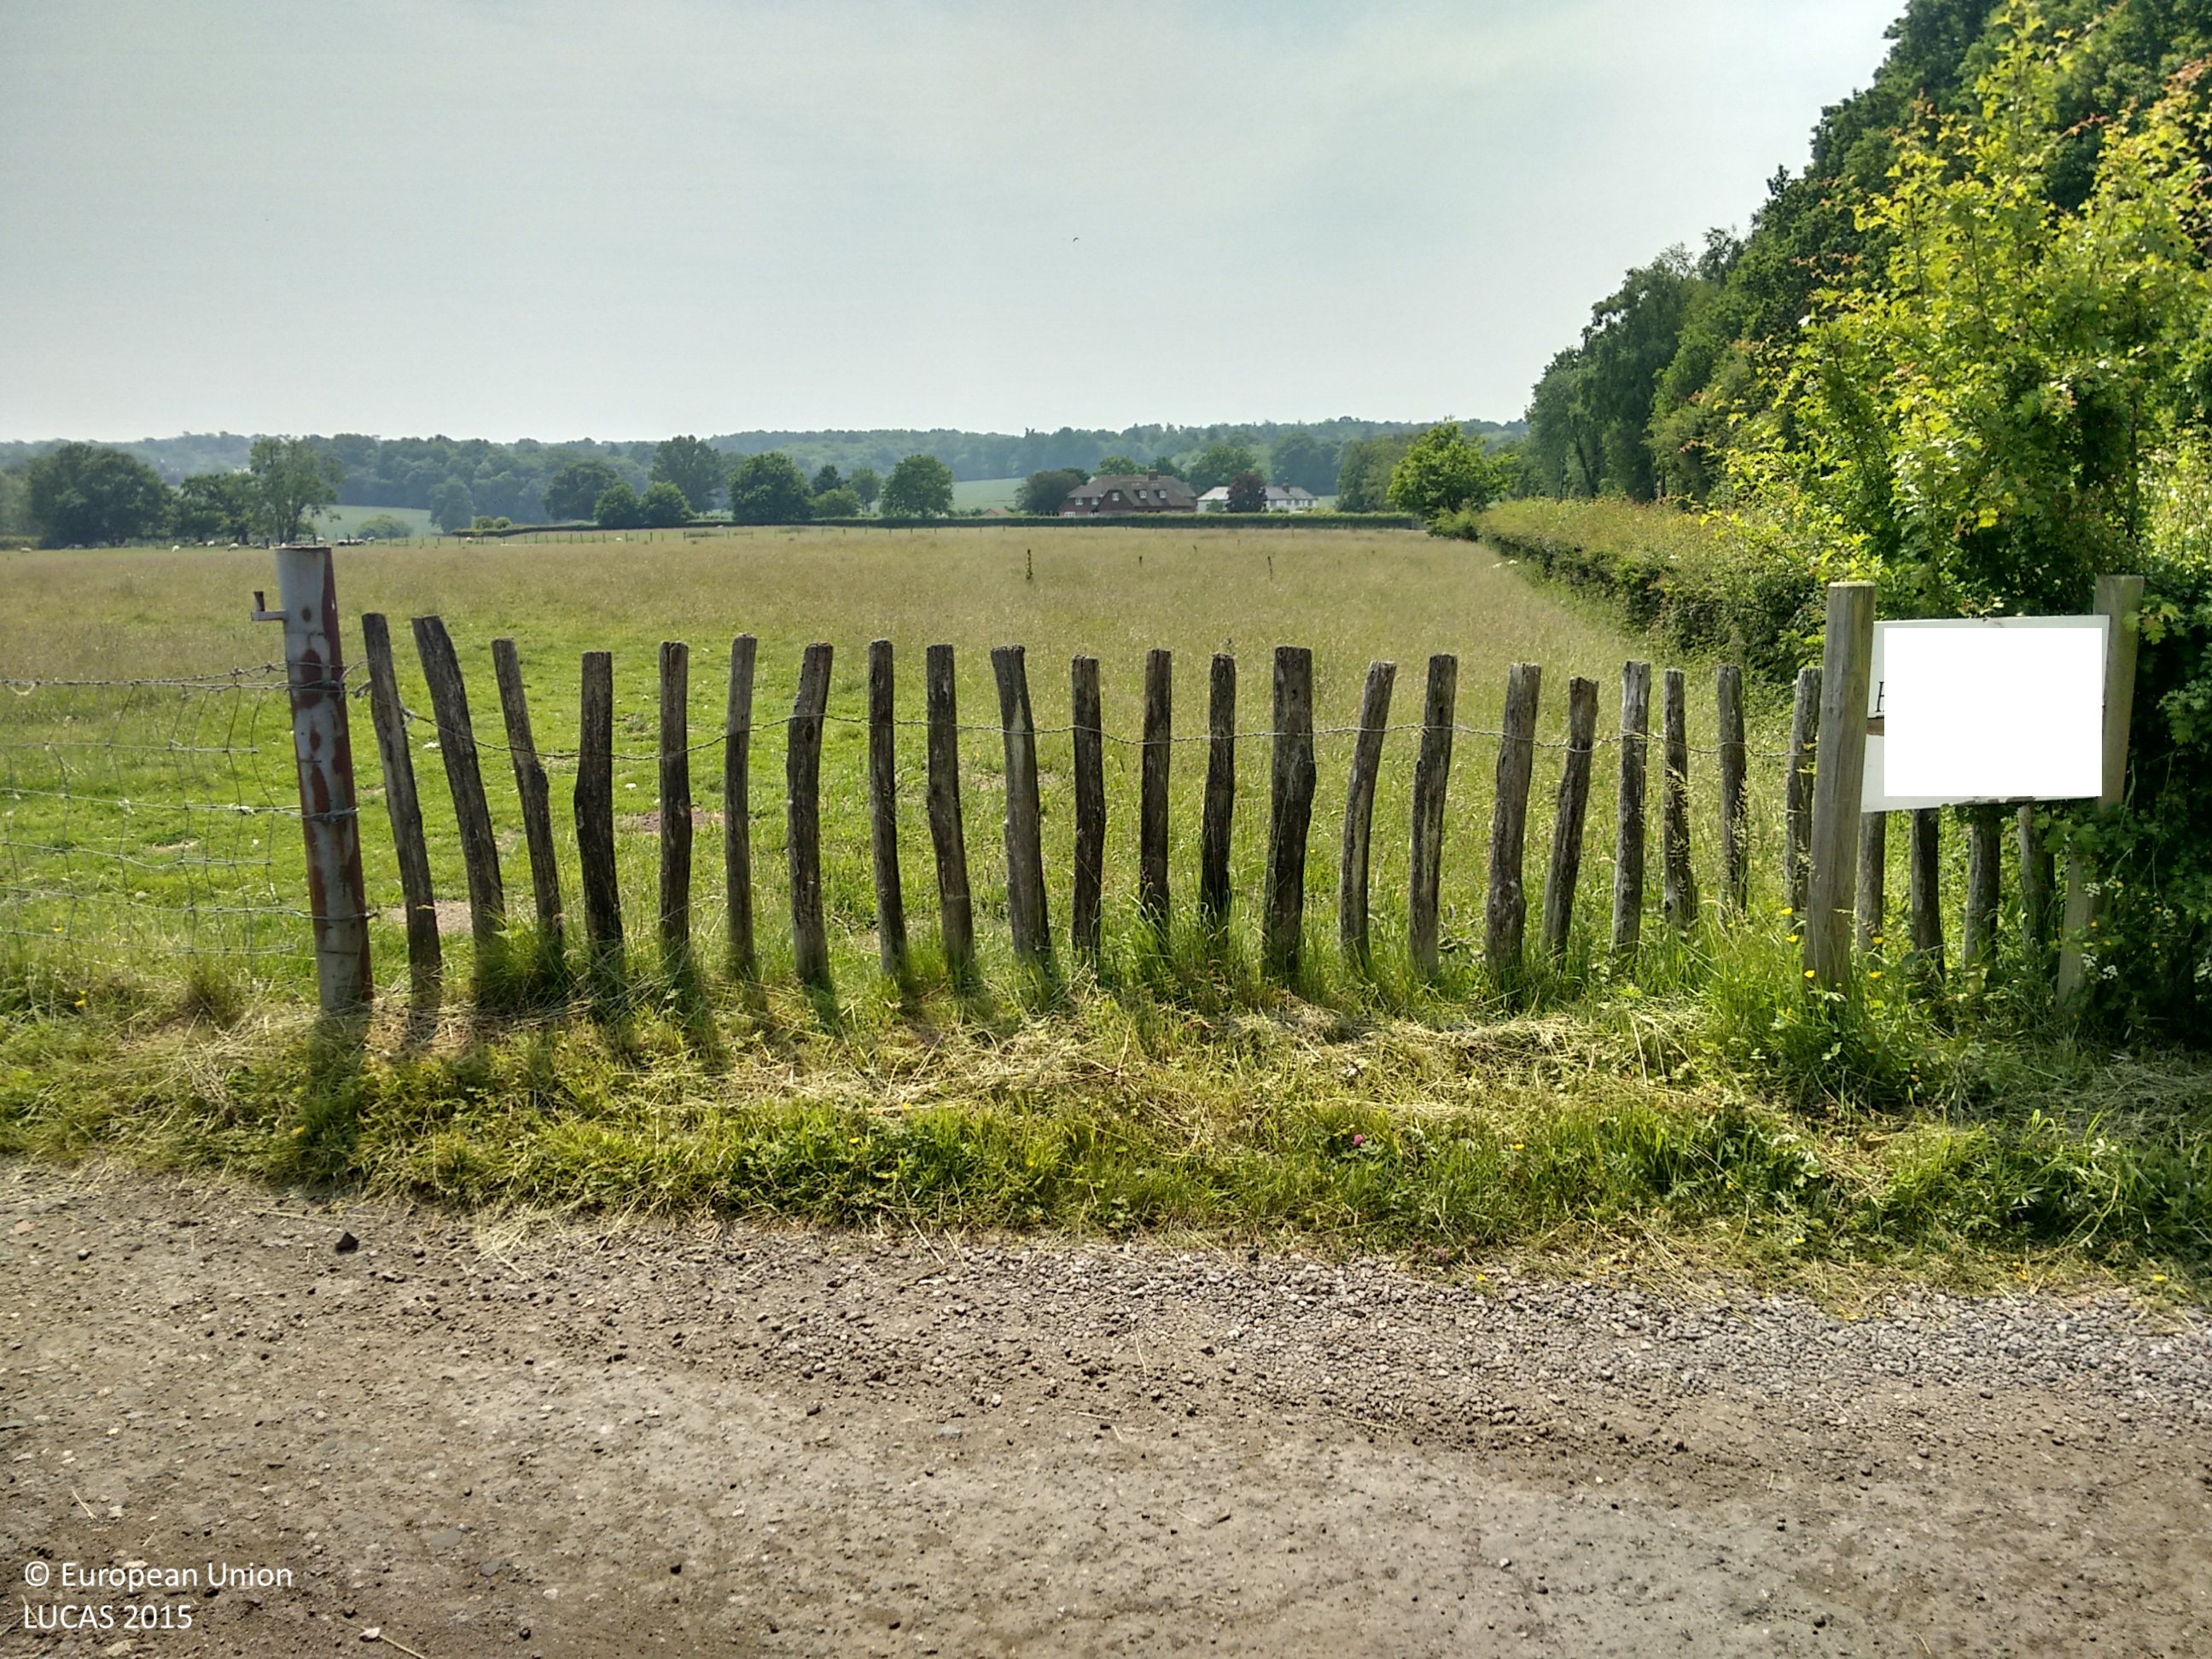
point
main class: Grassland
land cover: Grassland without tree/shrub cover
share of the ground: > 75 %
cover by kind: herbaceous plants 100 %
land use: Agriculture (excluding fallow land and kitchen gardens)
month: June
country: GB
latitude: 51.0970
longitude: 0.3607
